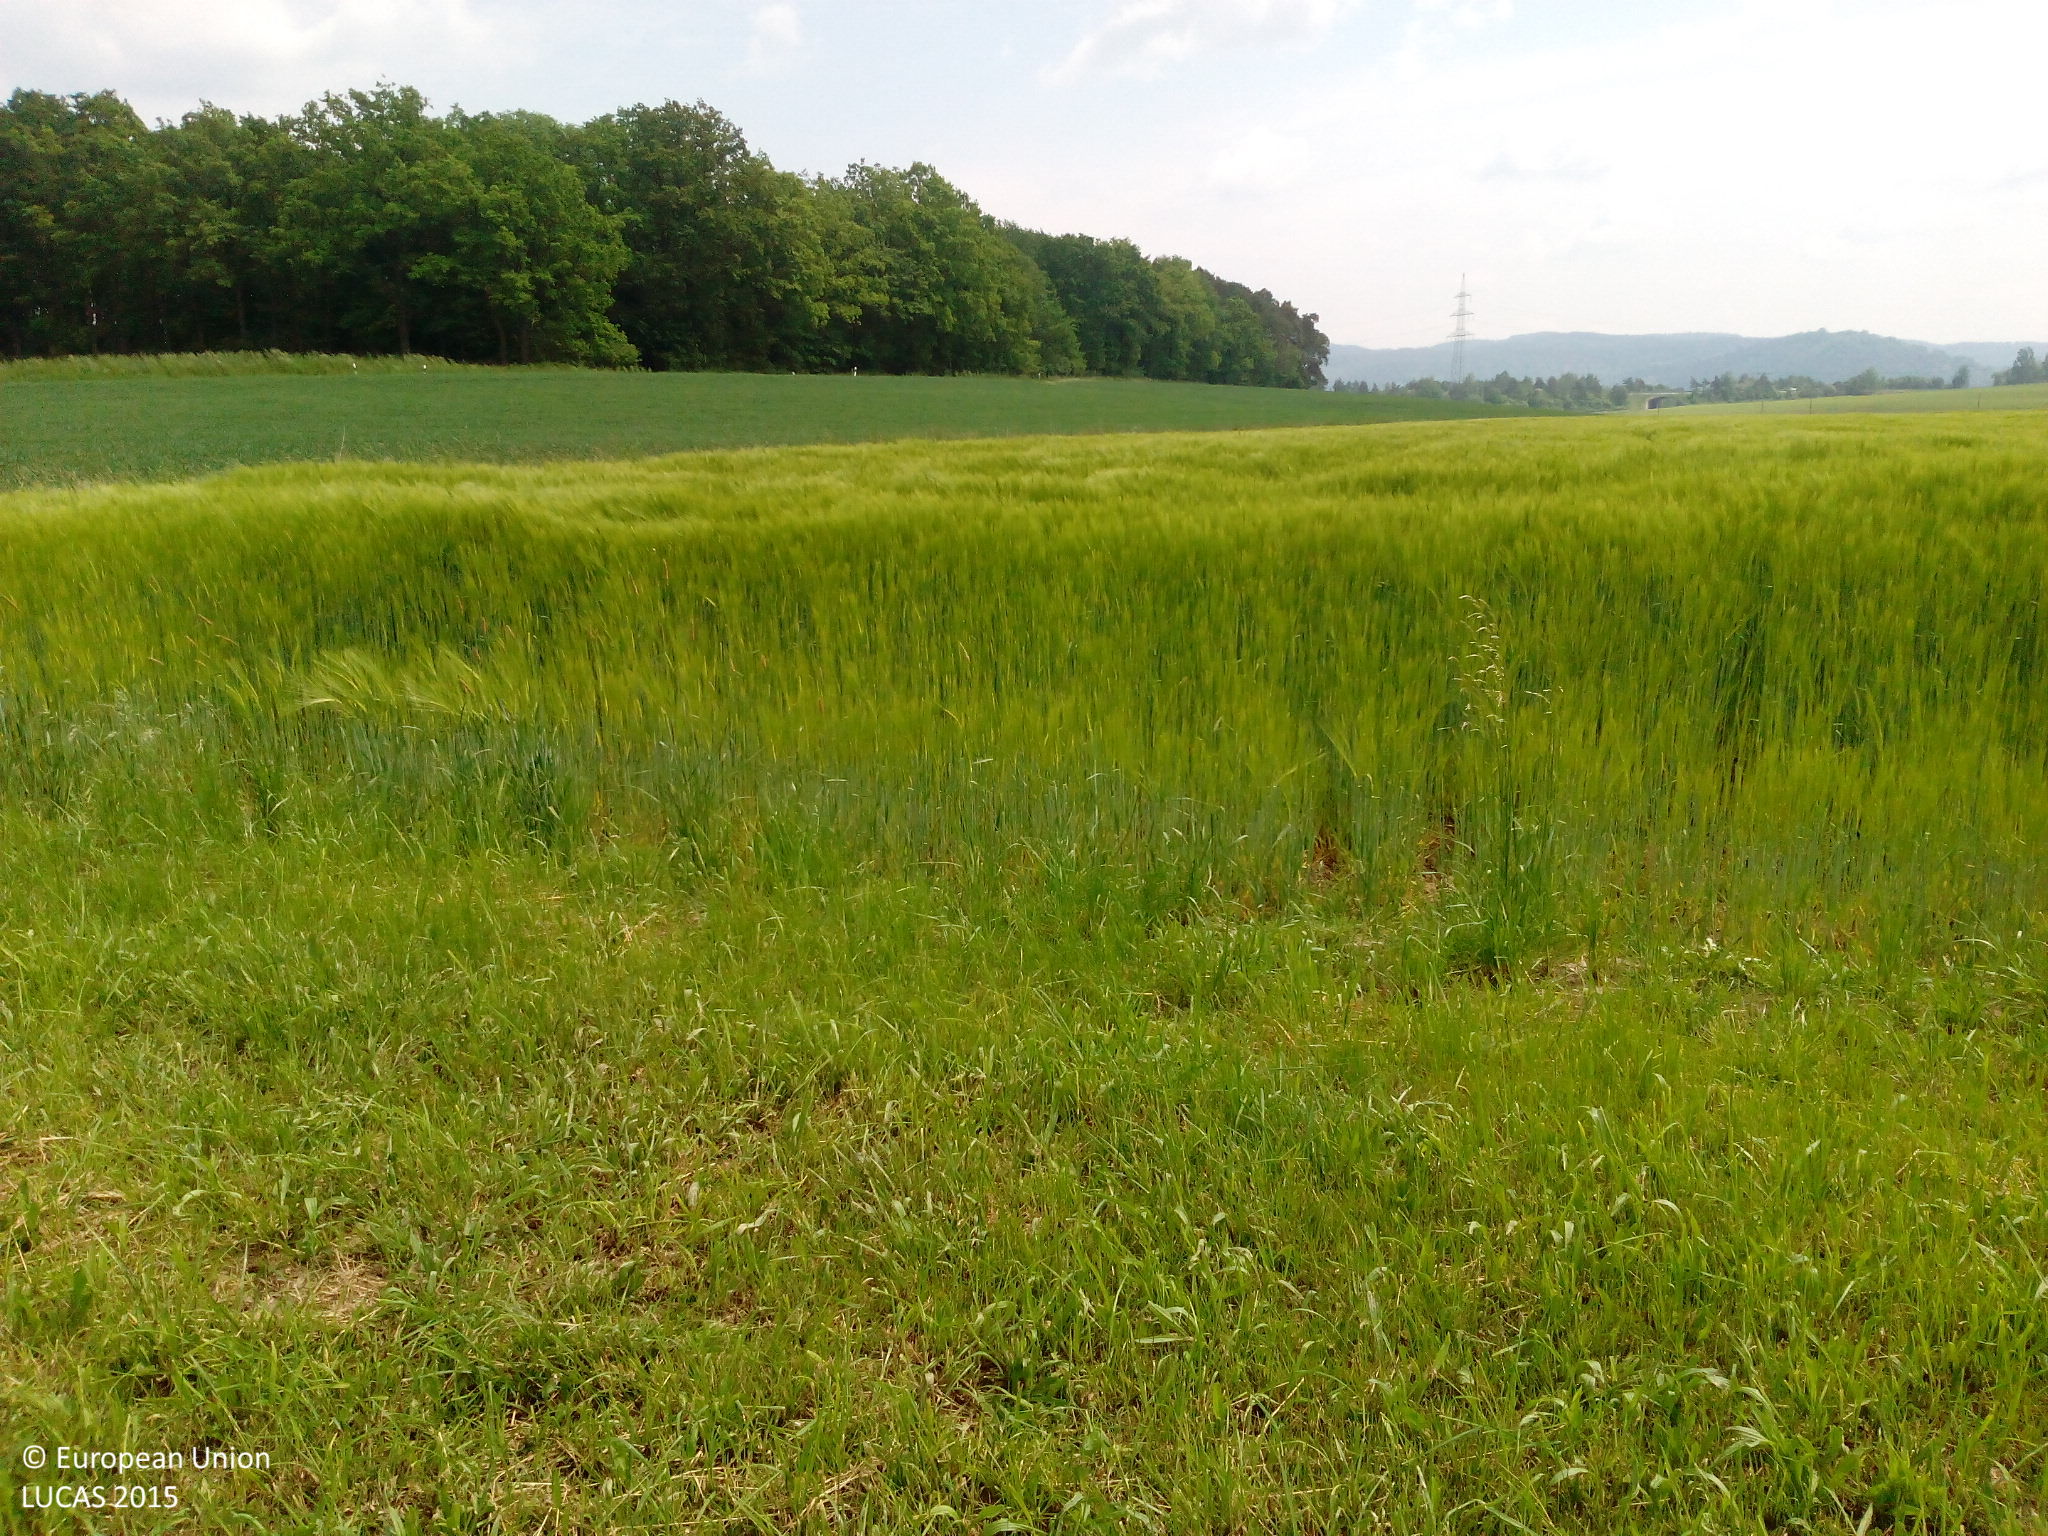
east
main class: Grassland
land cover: Grassland without tree/shrub cover
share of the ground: > 75 %
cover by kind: herbaceous plants 95 %, unconsolidated bare surface 5 %
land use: Agriculture (excluding fallow land and kitchen gardens)
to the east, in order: Grassland without tree/shrub cover; Barley; Grass margins; Ditches and canals; Spontaneously vegetated surfaces; Common wheat; Grass margins; Paved roads, cycling and walking lanes; Grass margins; Broadleaved woodland; Other mixed woodland
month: May
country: DE
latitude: 49.1395
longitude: 12.0966
